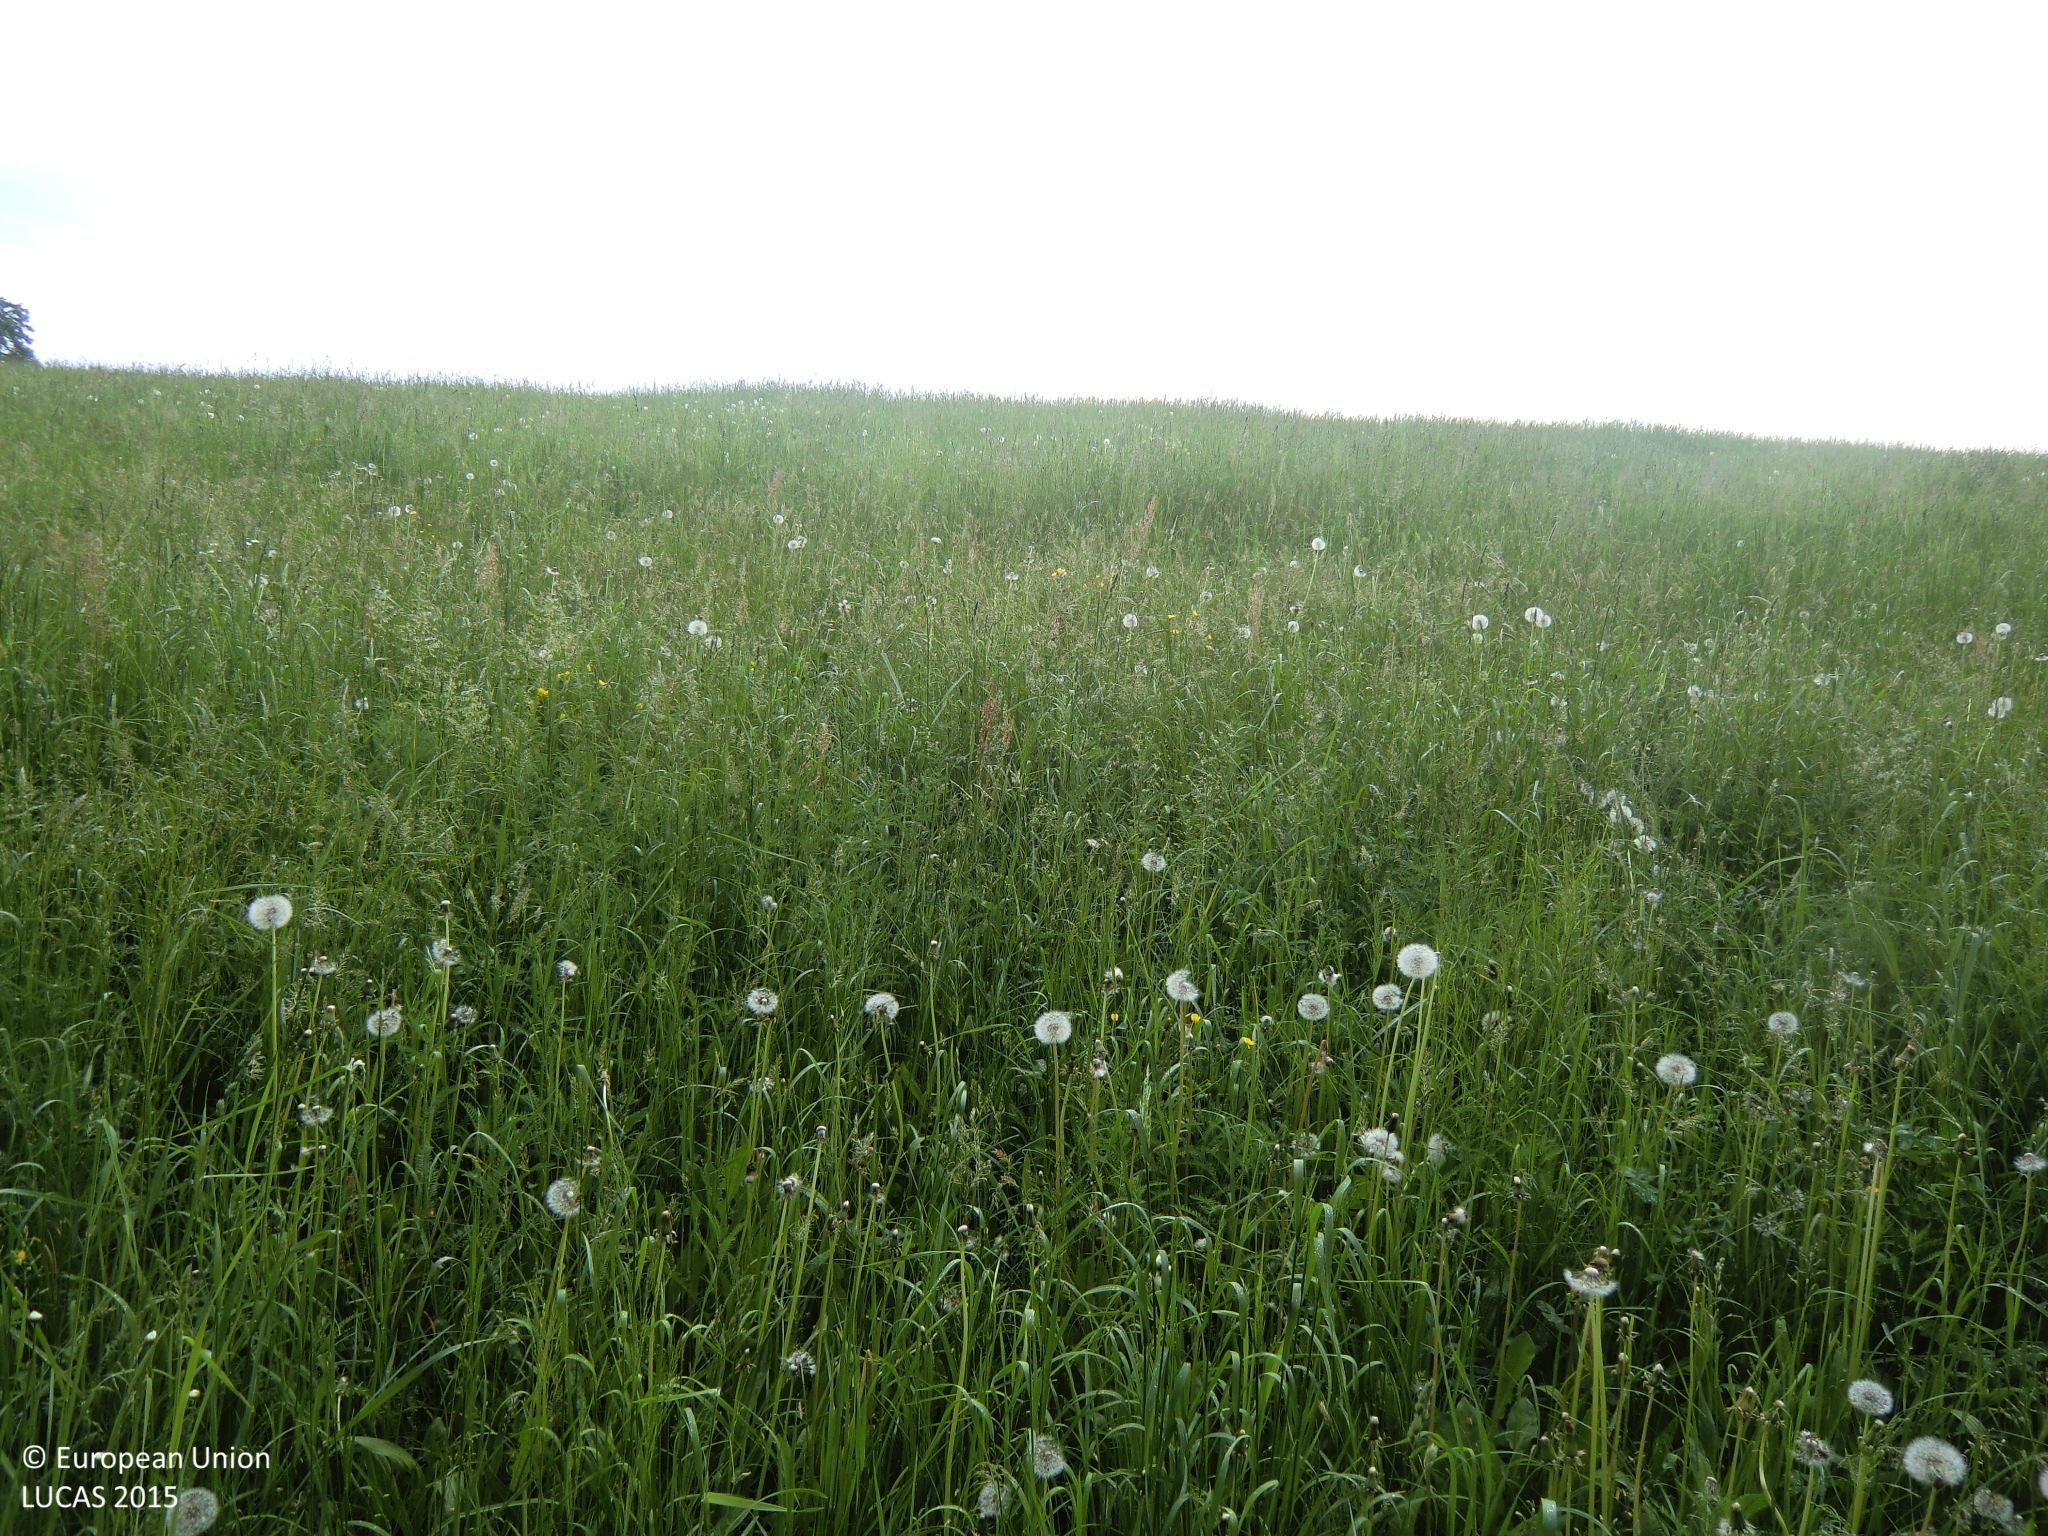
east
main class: Grassland
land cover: Grassland without tree/shrub cover
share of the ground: > 75 %
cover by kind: herbaceous plants 90 %, unconsolidated bare surface 10 %
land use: Agriculture (excluding fallow land and kitchen gardens)
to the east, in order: Grassland without tree/shrub cover; Paved roads, cycling and walking lanes; Grassland without tree/shrub cover; Spruce dominated coniferous woodland; Grassland without tree/shrub cover
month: May
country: AT
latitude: 48.3258
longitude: 14.5999
